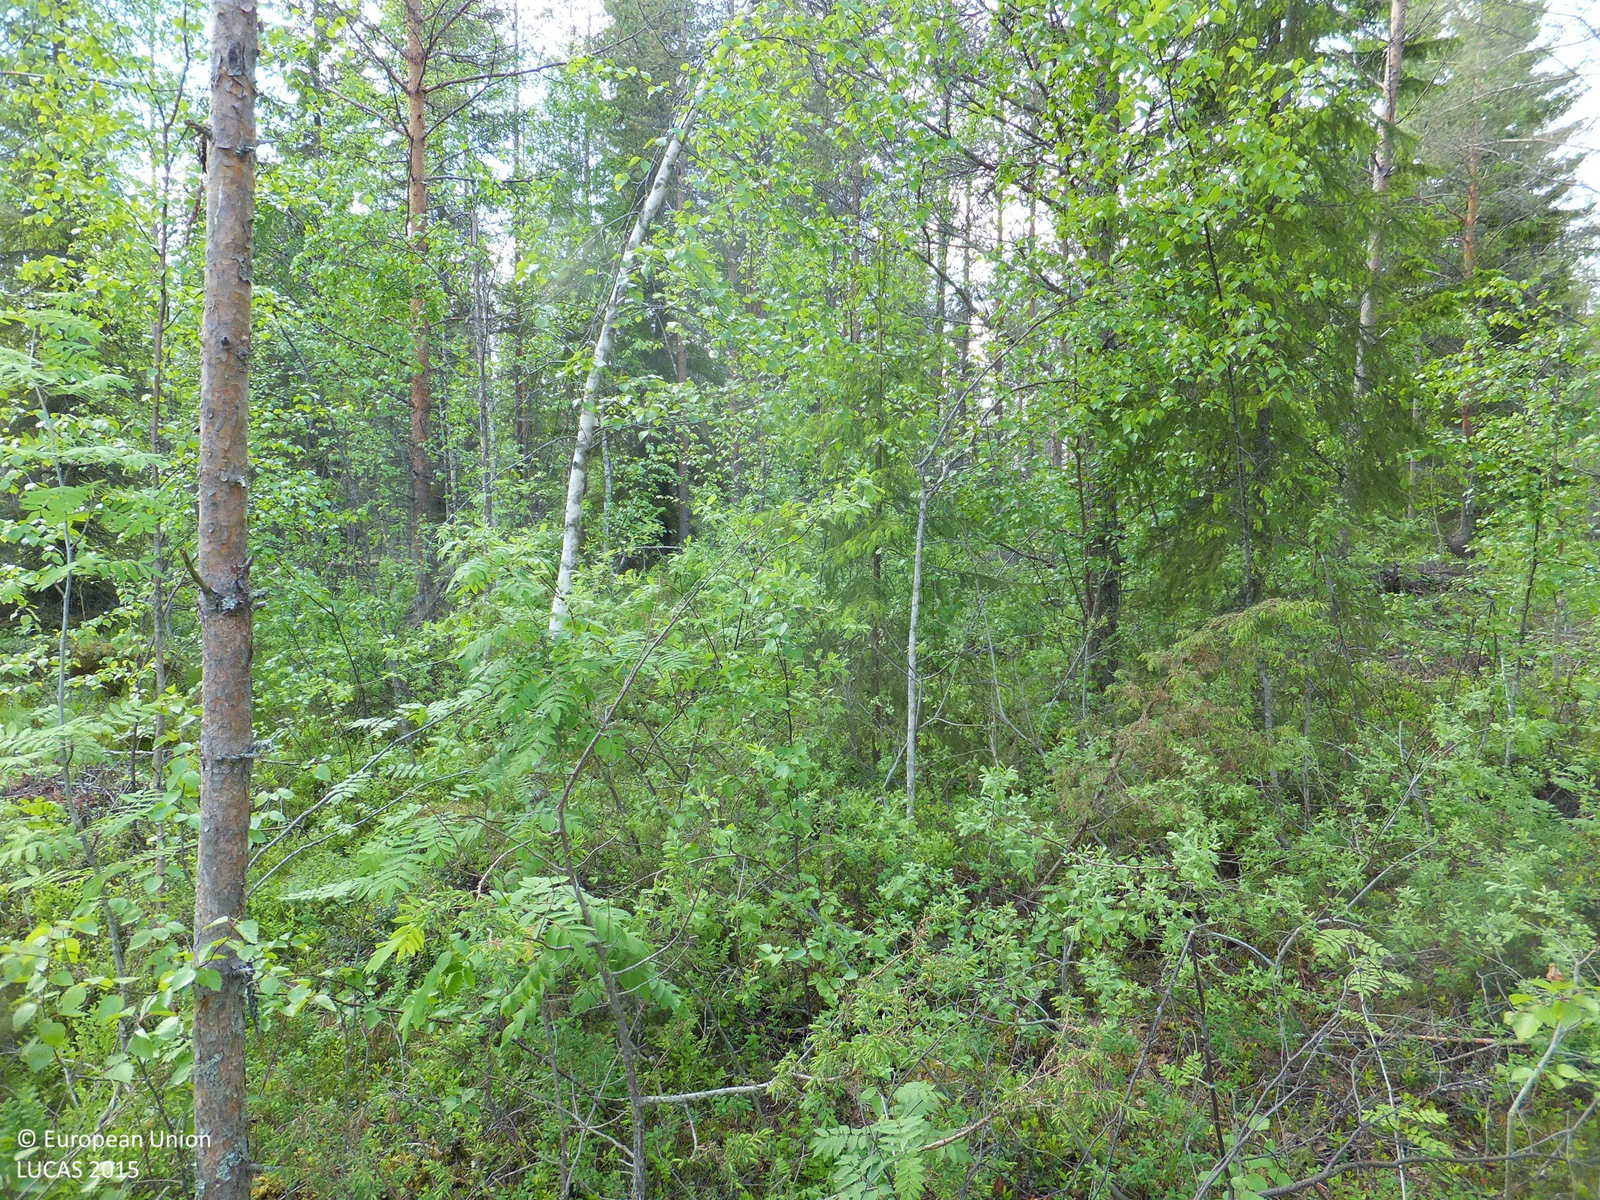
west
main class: Woodland
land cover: Other mixed woodland
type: boreal forest
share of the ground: > 75 %
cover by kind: coniferous forest trees 55 %, broadleaved forest trees 20 %, shrubs 15 %, herbaceous plants 5 %, lichens and mosses 5 %
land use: Forestry
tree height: > 5 m
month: June
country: FI
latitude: 63.5617
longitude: 24.1033
